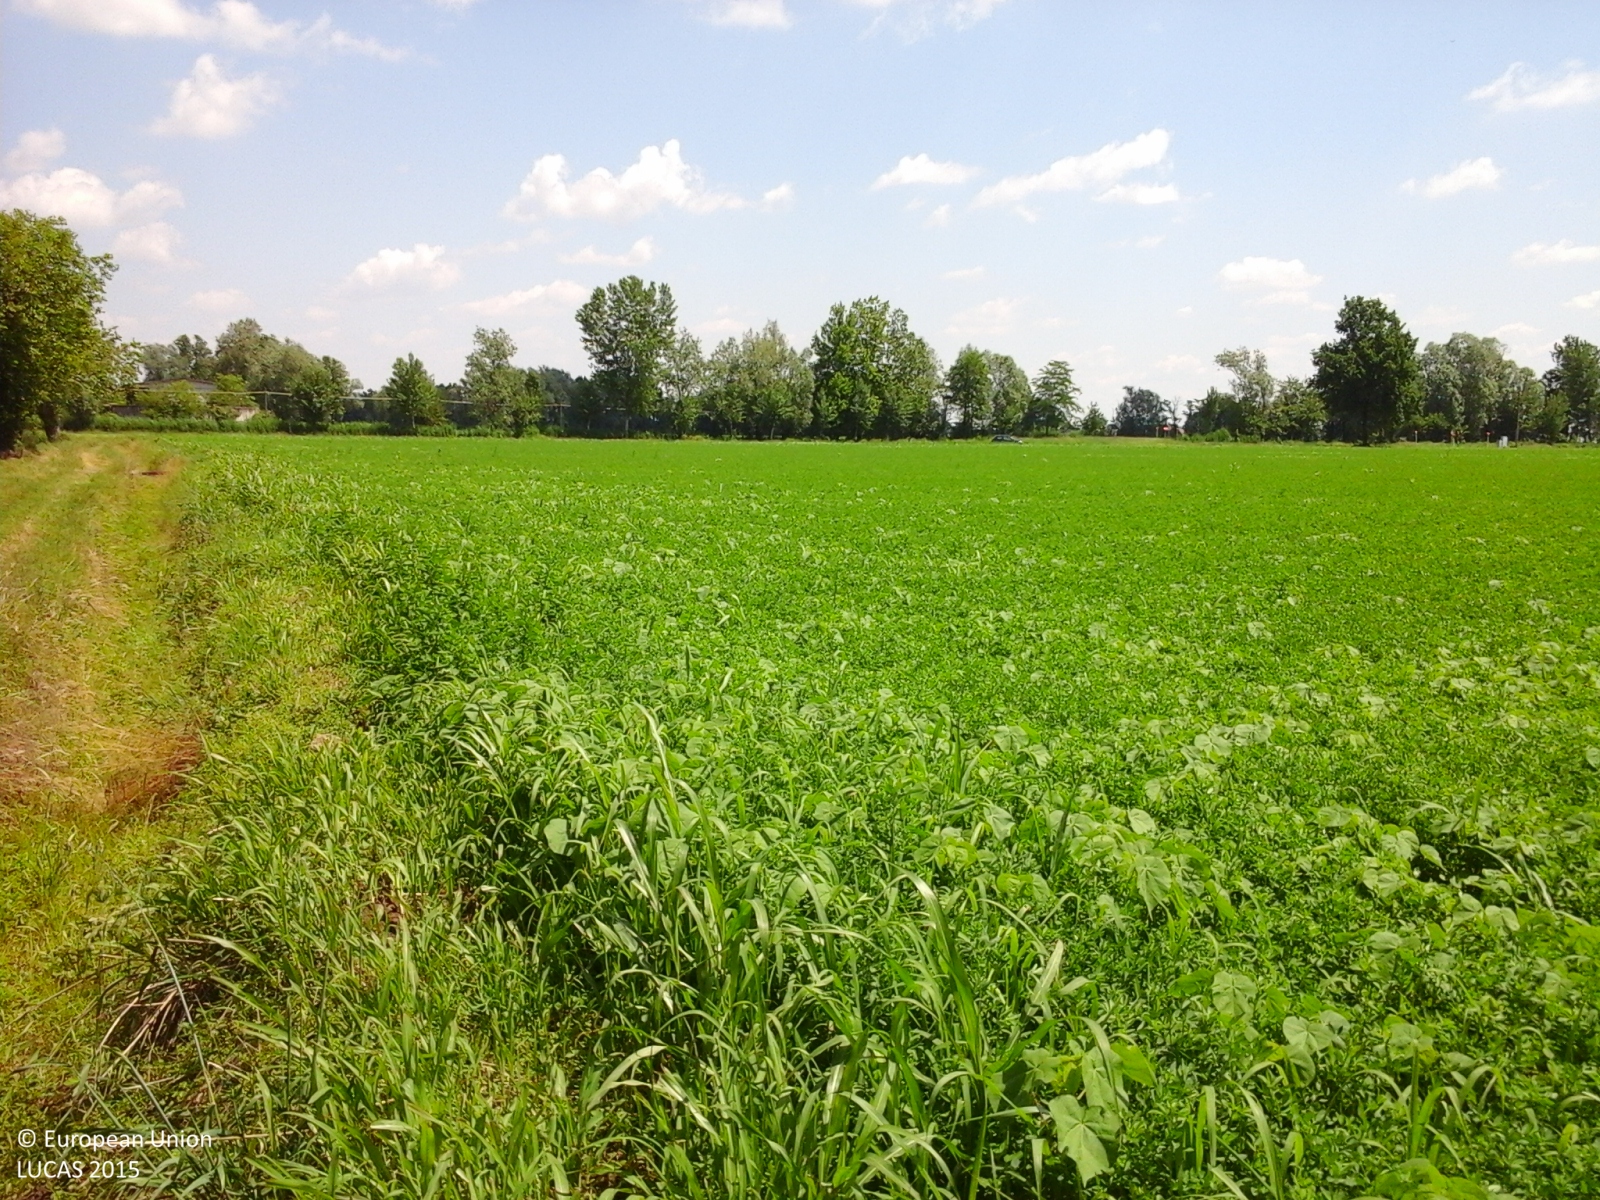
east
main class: Cropland
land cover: Lucerne
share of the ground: > 75 %
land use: Agriculture (excluding fallow land and kitchen gardens)
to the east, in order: Lucerne; Grass margins; Ditches and canals; Grass margins; Paved roads, cycling and walking lanes; Grass margins; Ditches and canals; Temporary grasslands; Managed hedges; Ditches and canals; Managed hedges; Maize
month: May
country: IT
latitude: 45.4318
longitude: 9.6555
